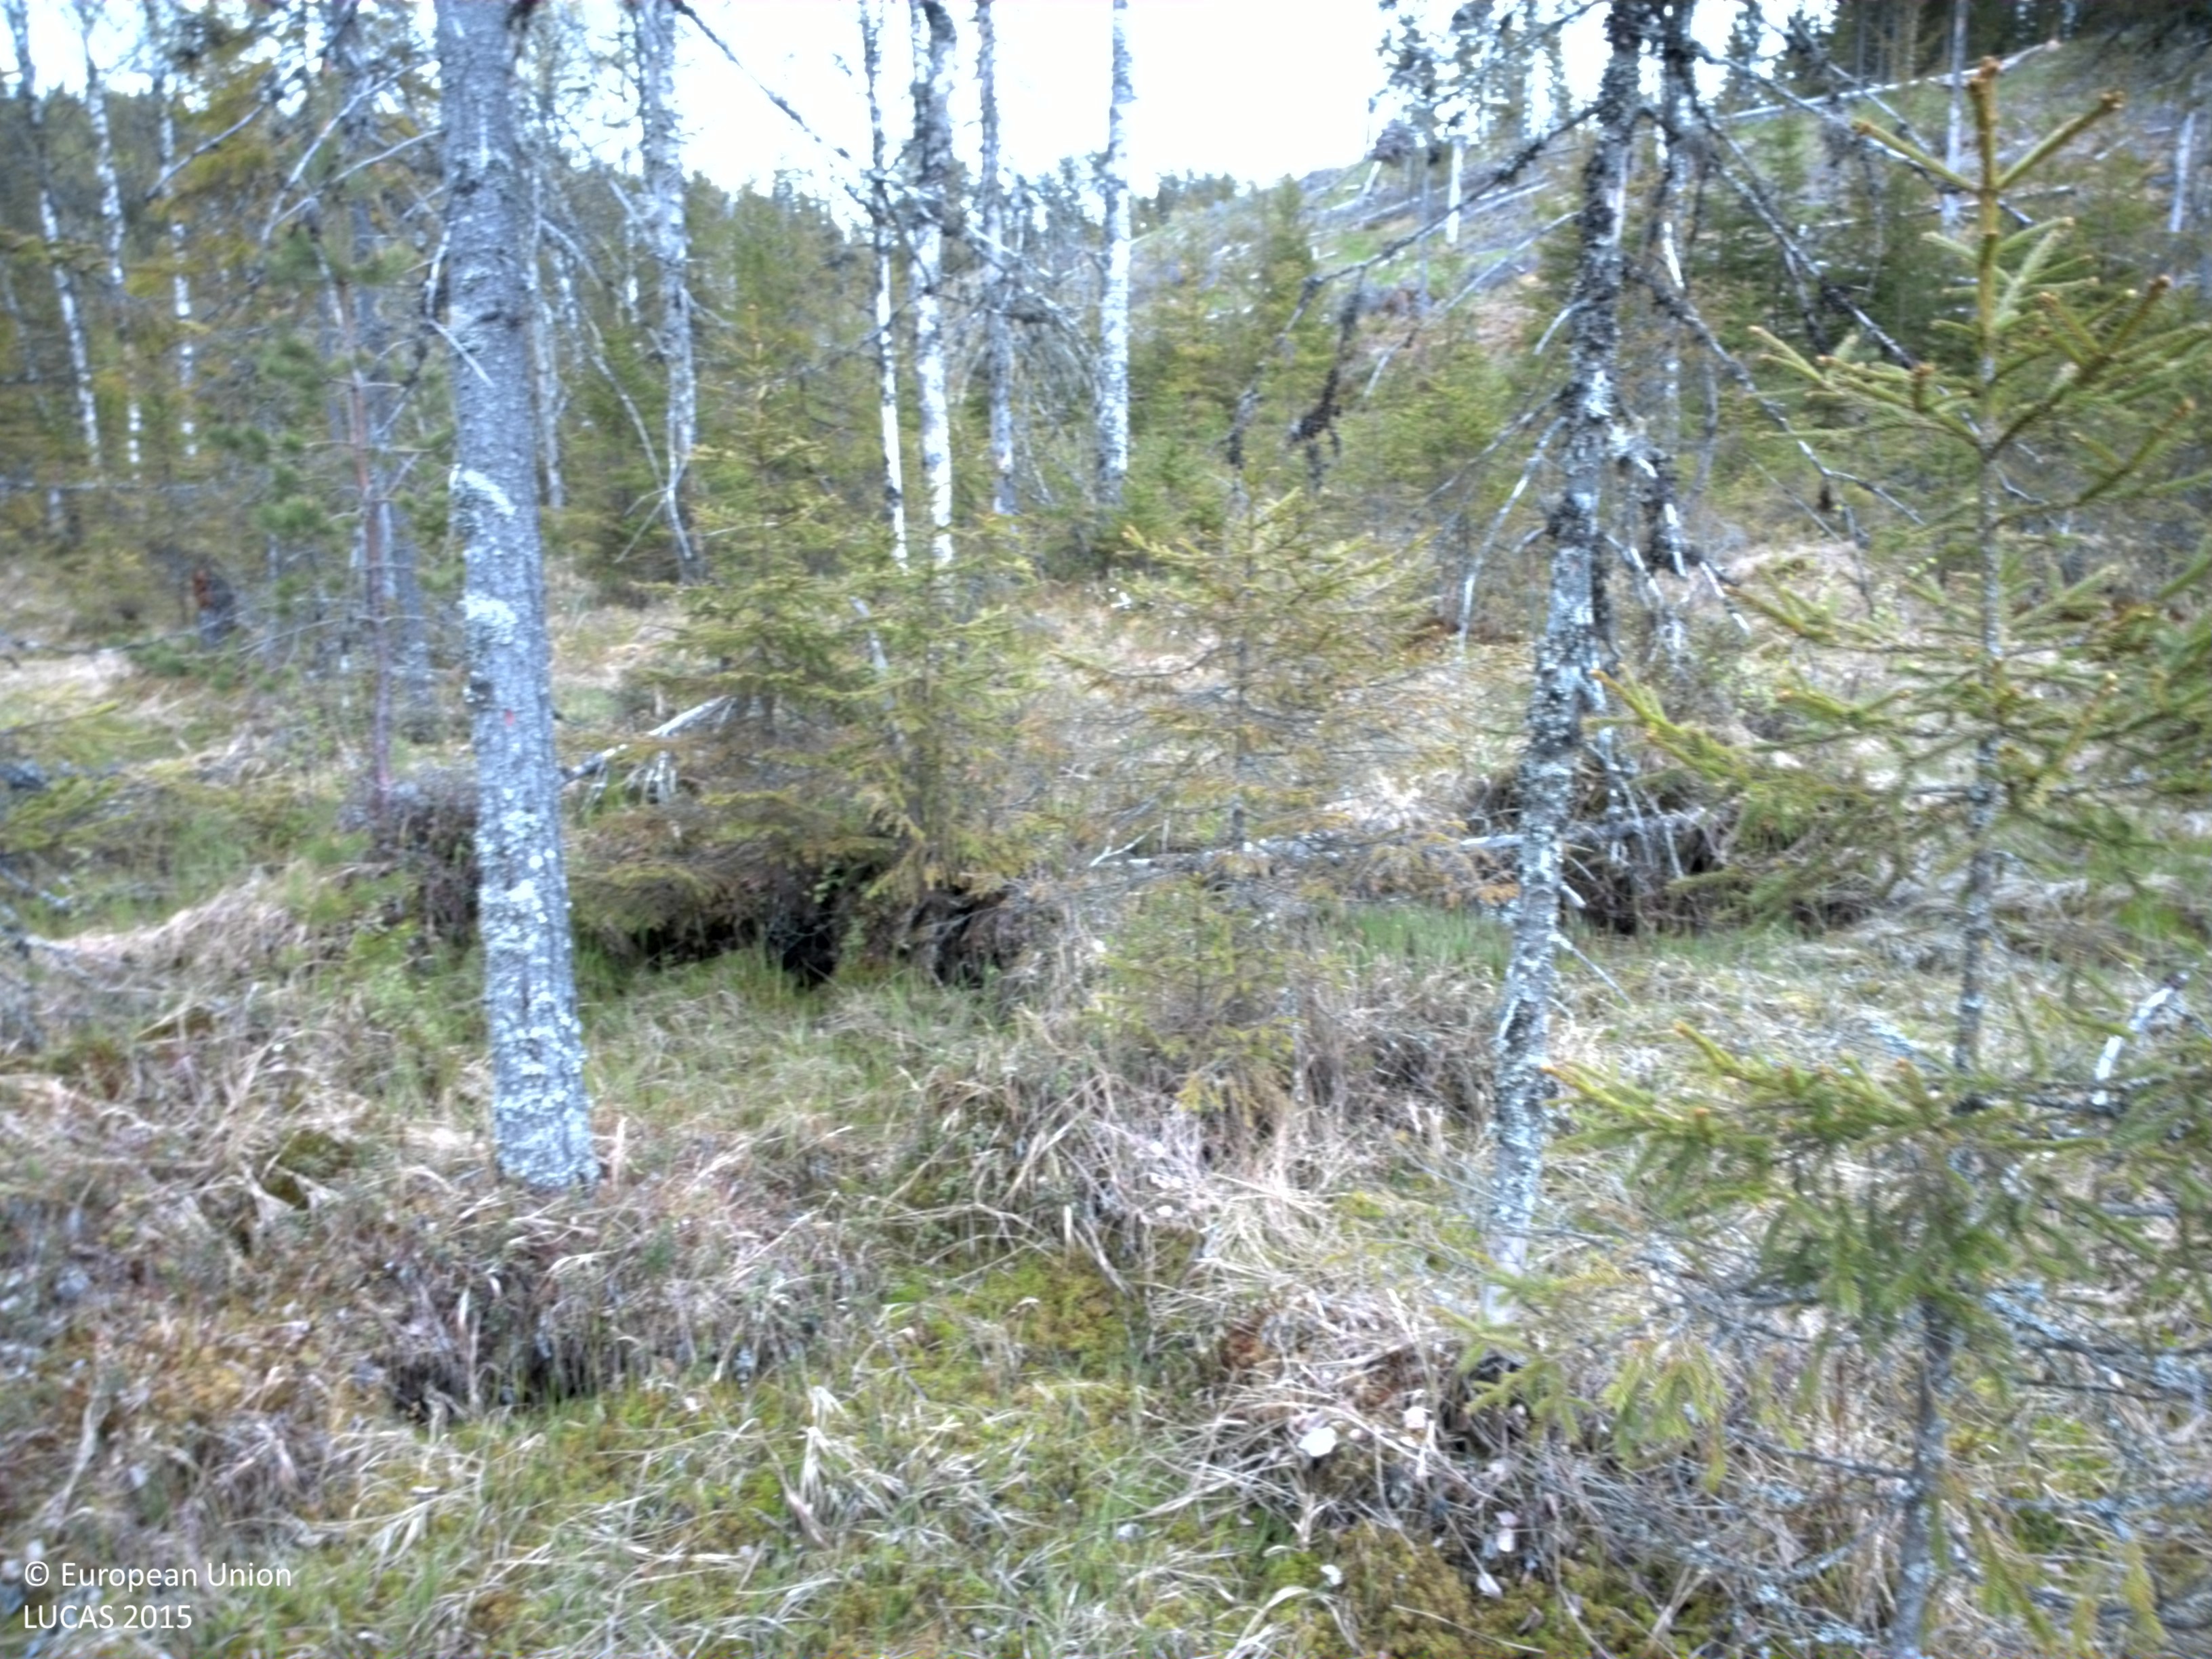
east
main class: Woodland
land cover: Spruce dominated coniferous woodland
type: boreal forest
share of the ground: 10 - 25 %
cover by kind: herbaceous plants 65 %, coniferous forest trees 20 %, shrubs 15 %
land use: Forestry
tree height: < 5 m
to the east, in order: Spruce dominated coniferous woodland; Rivers and streams; Shrubland with sparse tree cover; Grassland with sparse tree/shrub cover; Grass margins; Paved roads, cycling and walking lanes; Grass margins; Grassland with sparse tree/shrub cover
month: May
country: SE
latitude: 59.6394
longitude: 12.3174
